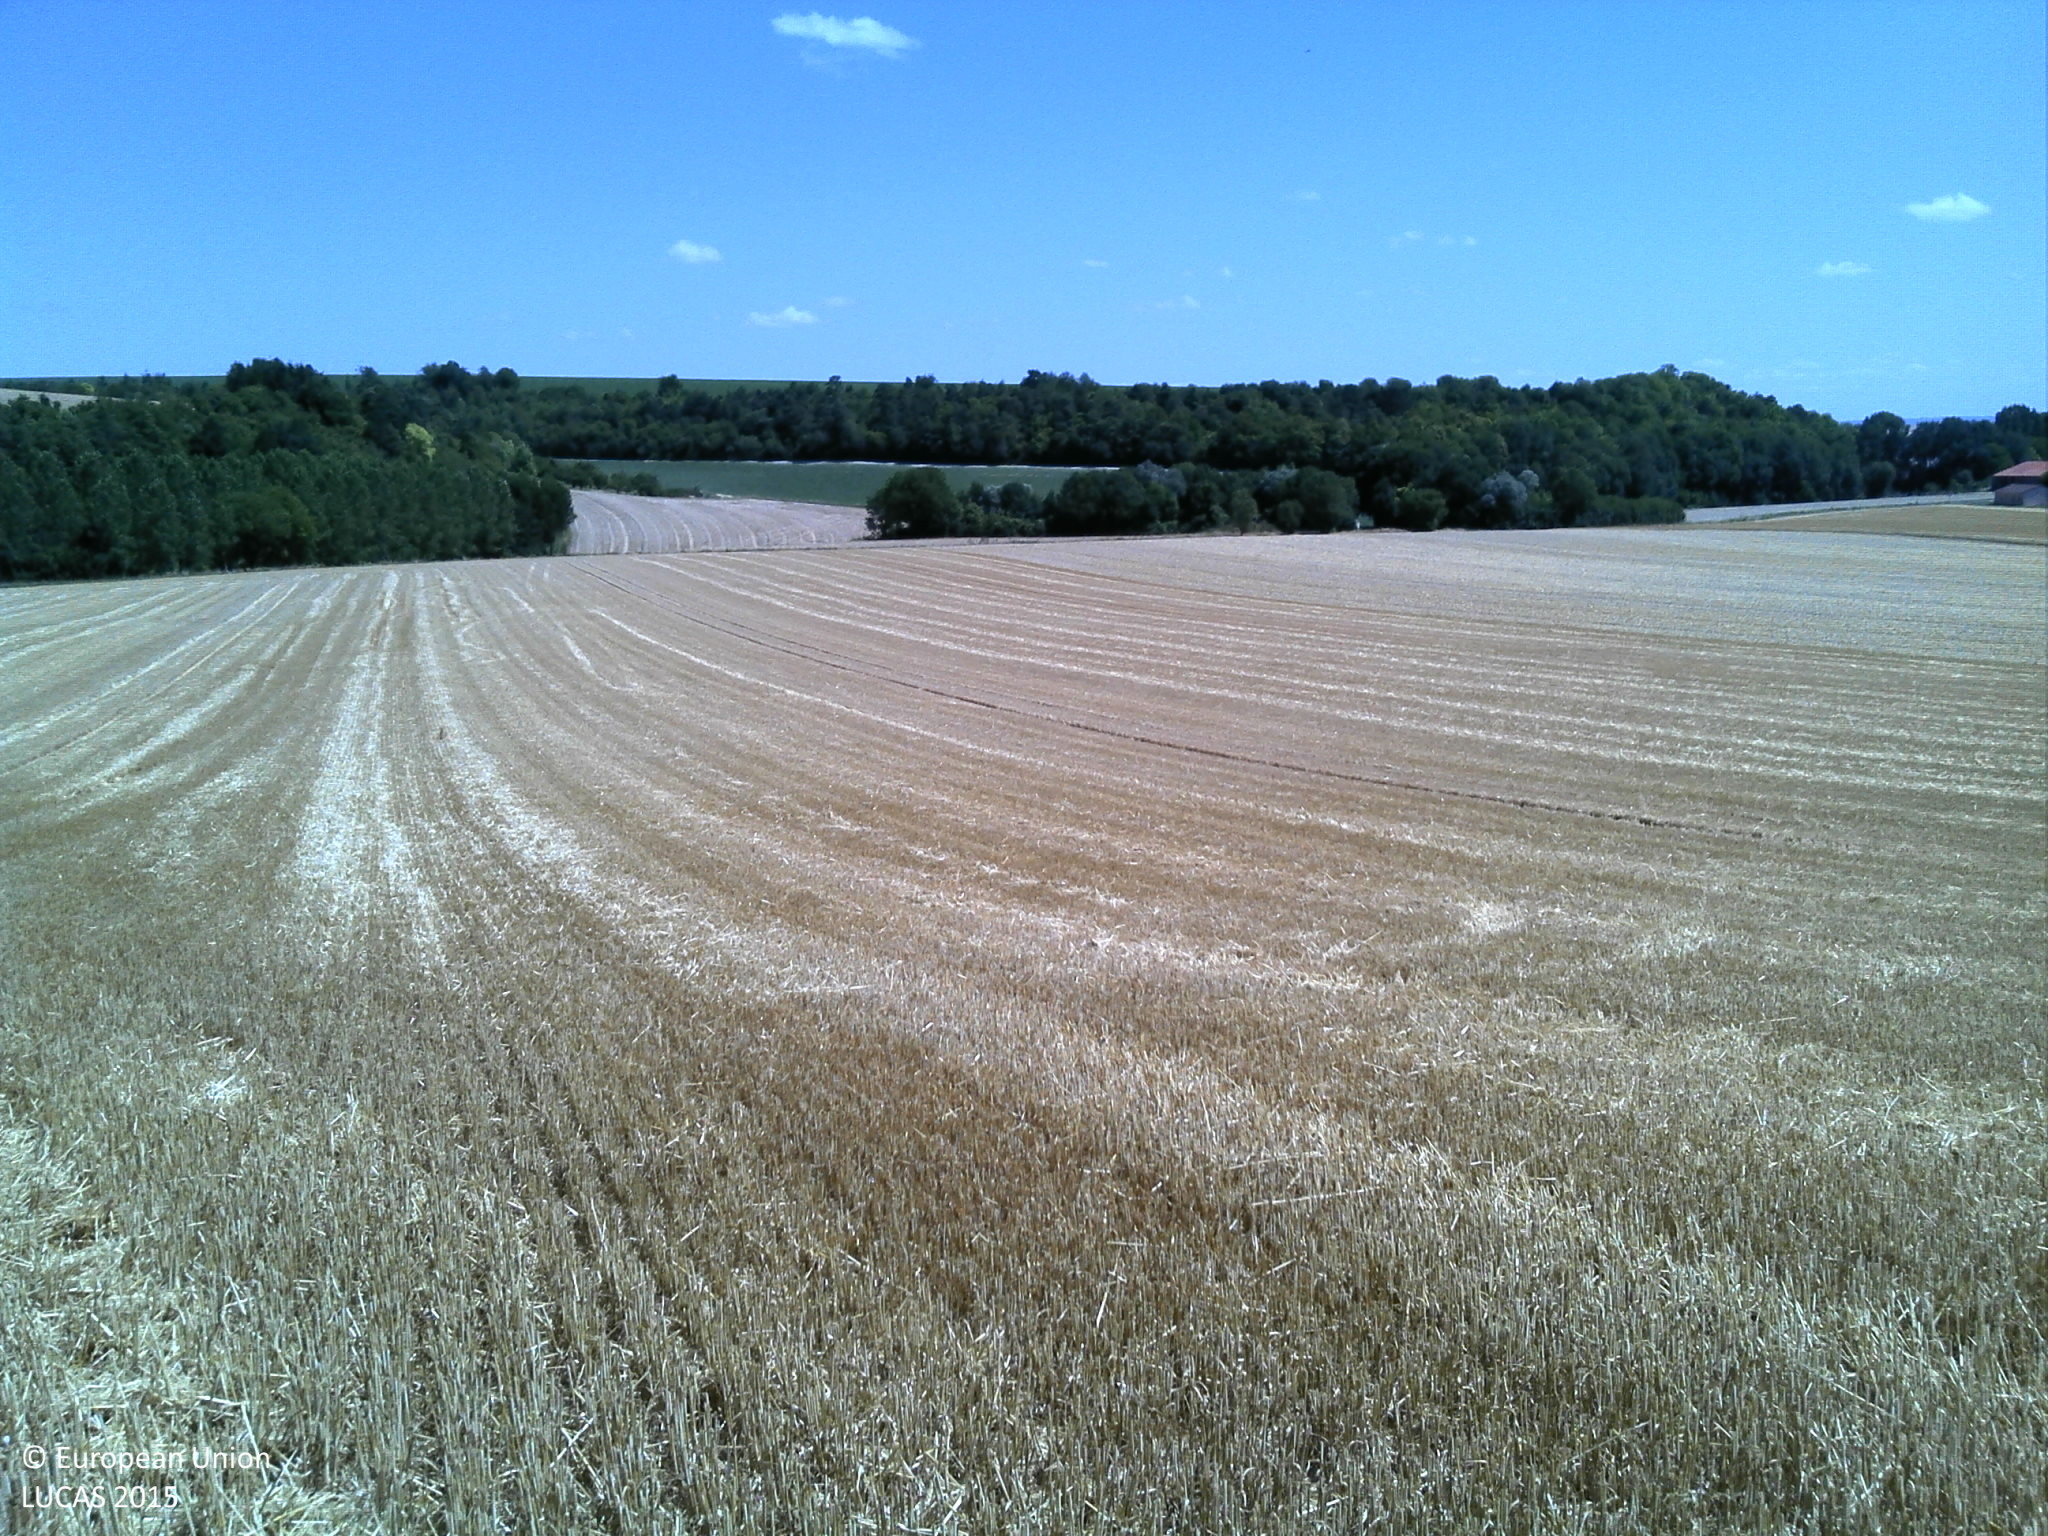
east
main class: Cropland
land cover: Common wheat
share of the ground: > 75 %
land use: Agriculture (excluding fallow land and kitchen gardens)
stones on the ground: < 10 %
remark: Harvested field
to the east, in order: Common wheat
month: July
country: FR
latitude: 48.8724
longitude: 4.7210
